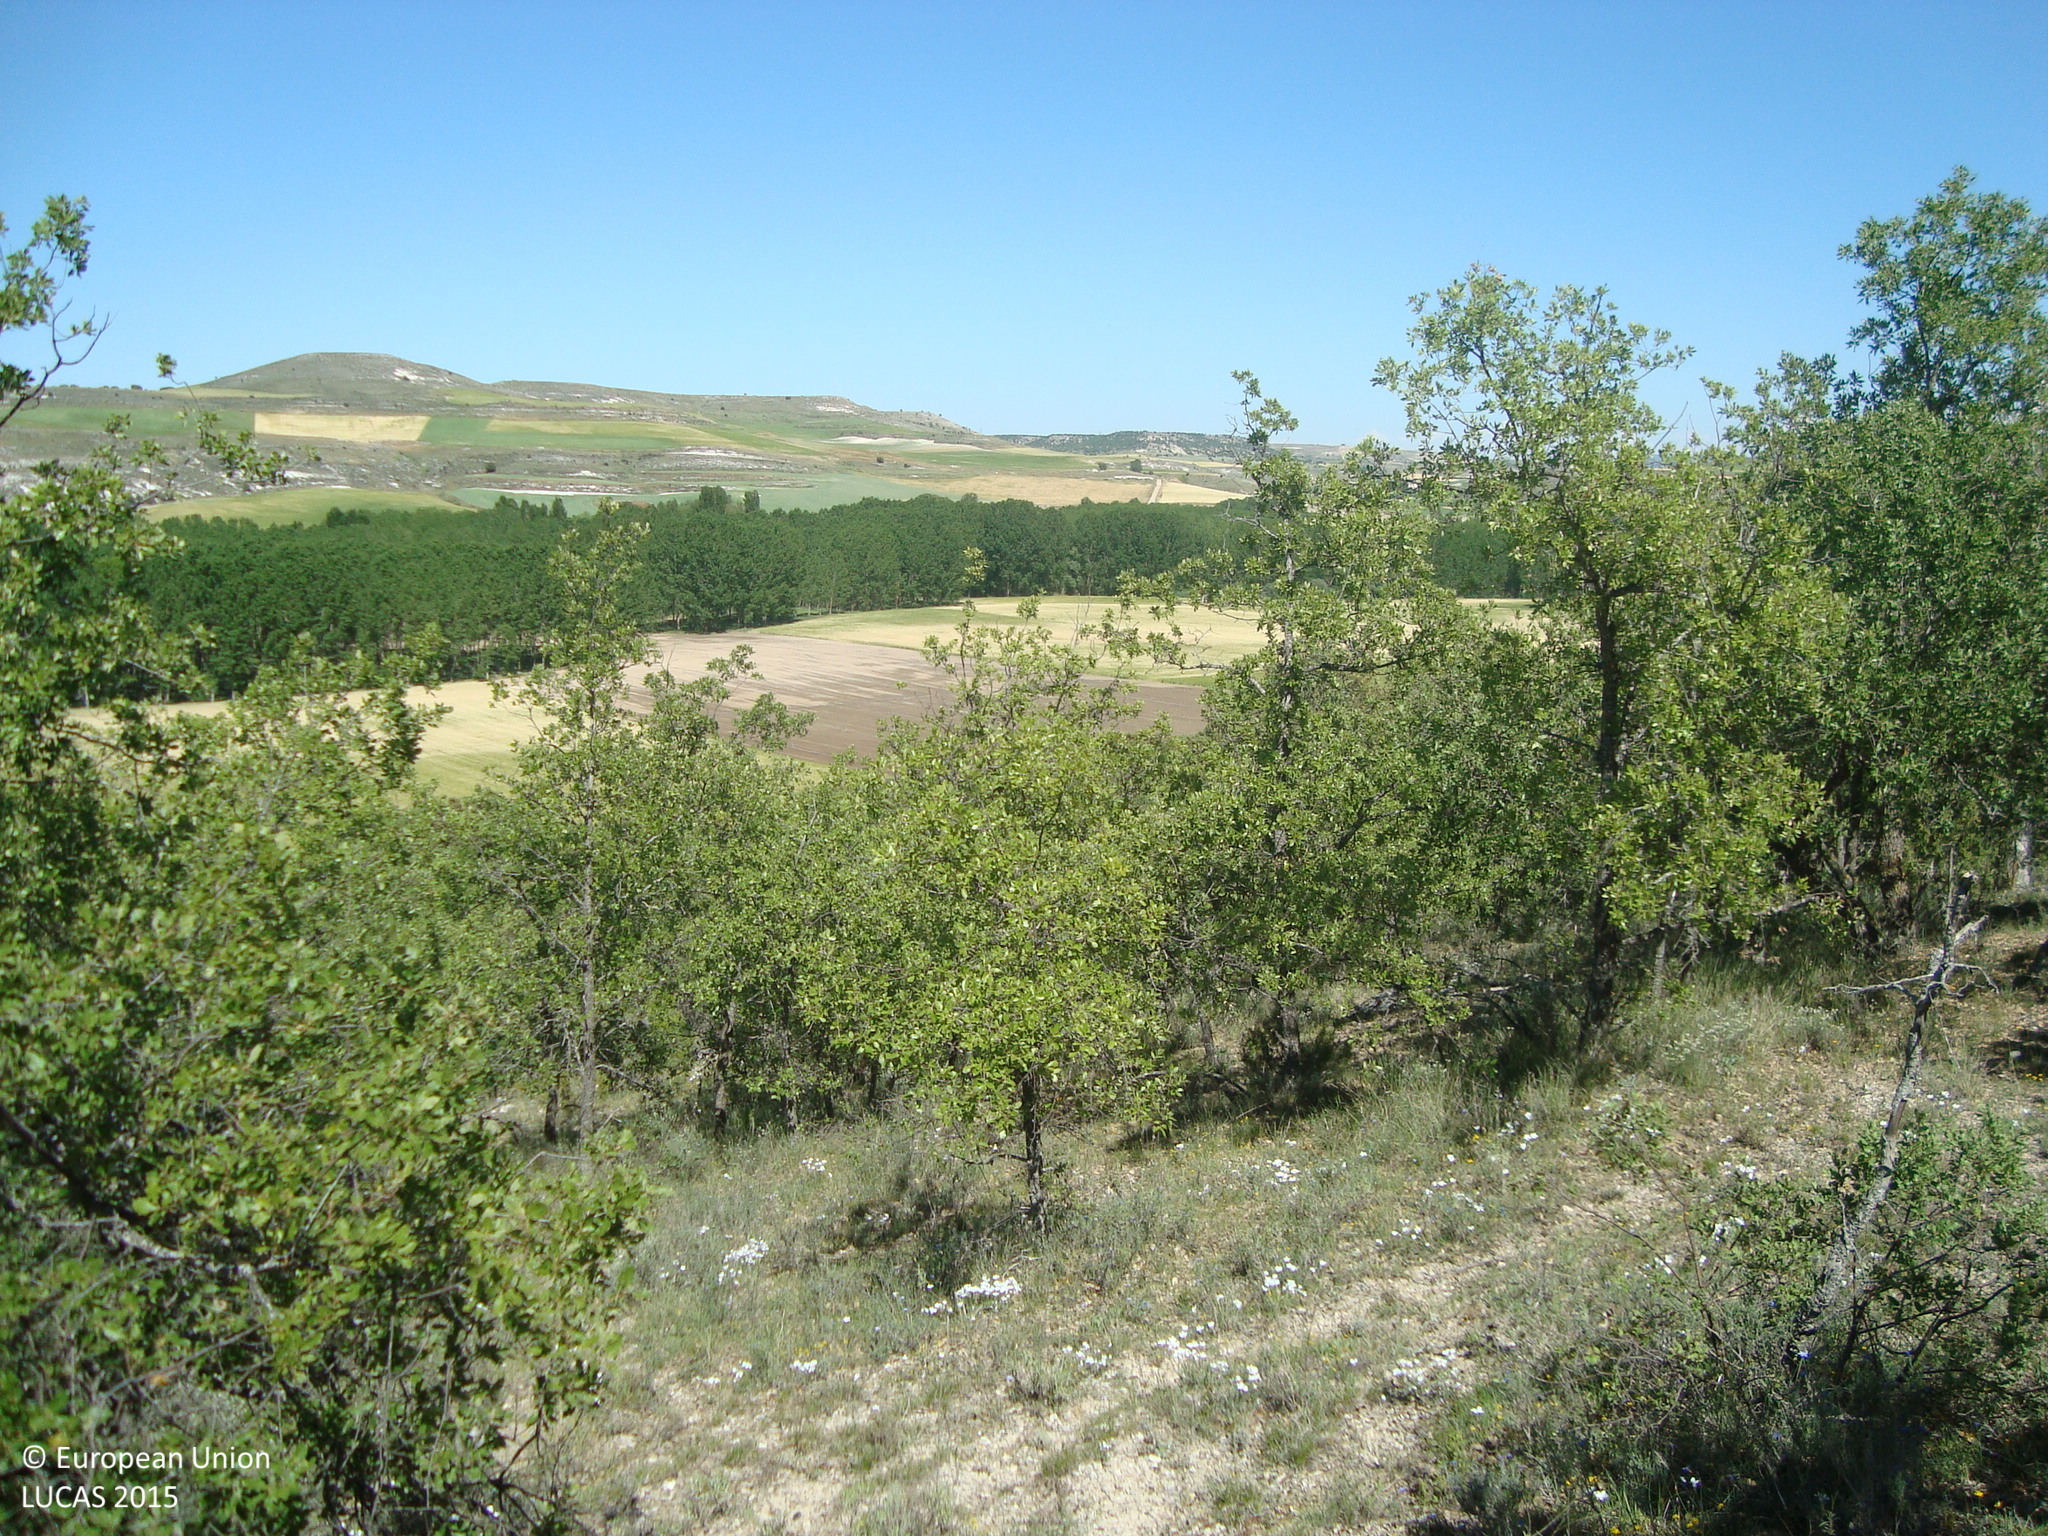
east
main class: Woodland
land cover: Broadleaved woodland
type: thermophilous deciduous forest
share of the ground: 50 - 75 %
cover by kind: broadleaved forest trees 55 %, herbaceous plants 25 %, shrubs 20 %
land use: Semi-natural and natural areas not in use
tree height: < 5 m
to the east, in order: Broadleaved woodland; Electric lines; Broadleaved woodland; Tracks; Grass margins; Sugar beet
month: May
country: ES
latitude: 41.5062
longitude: -4.0374
